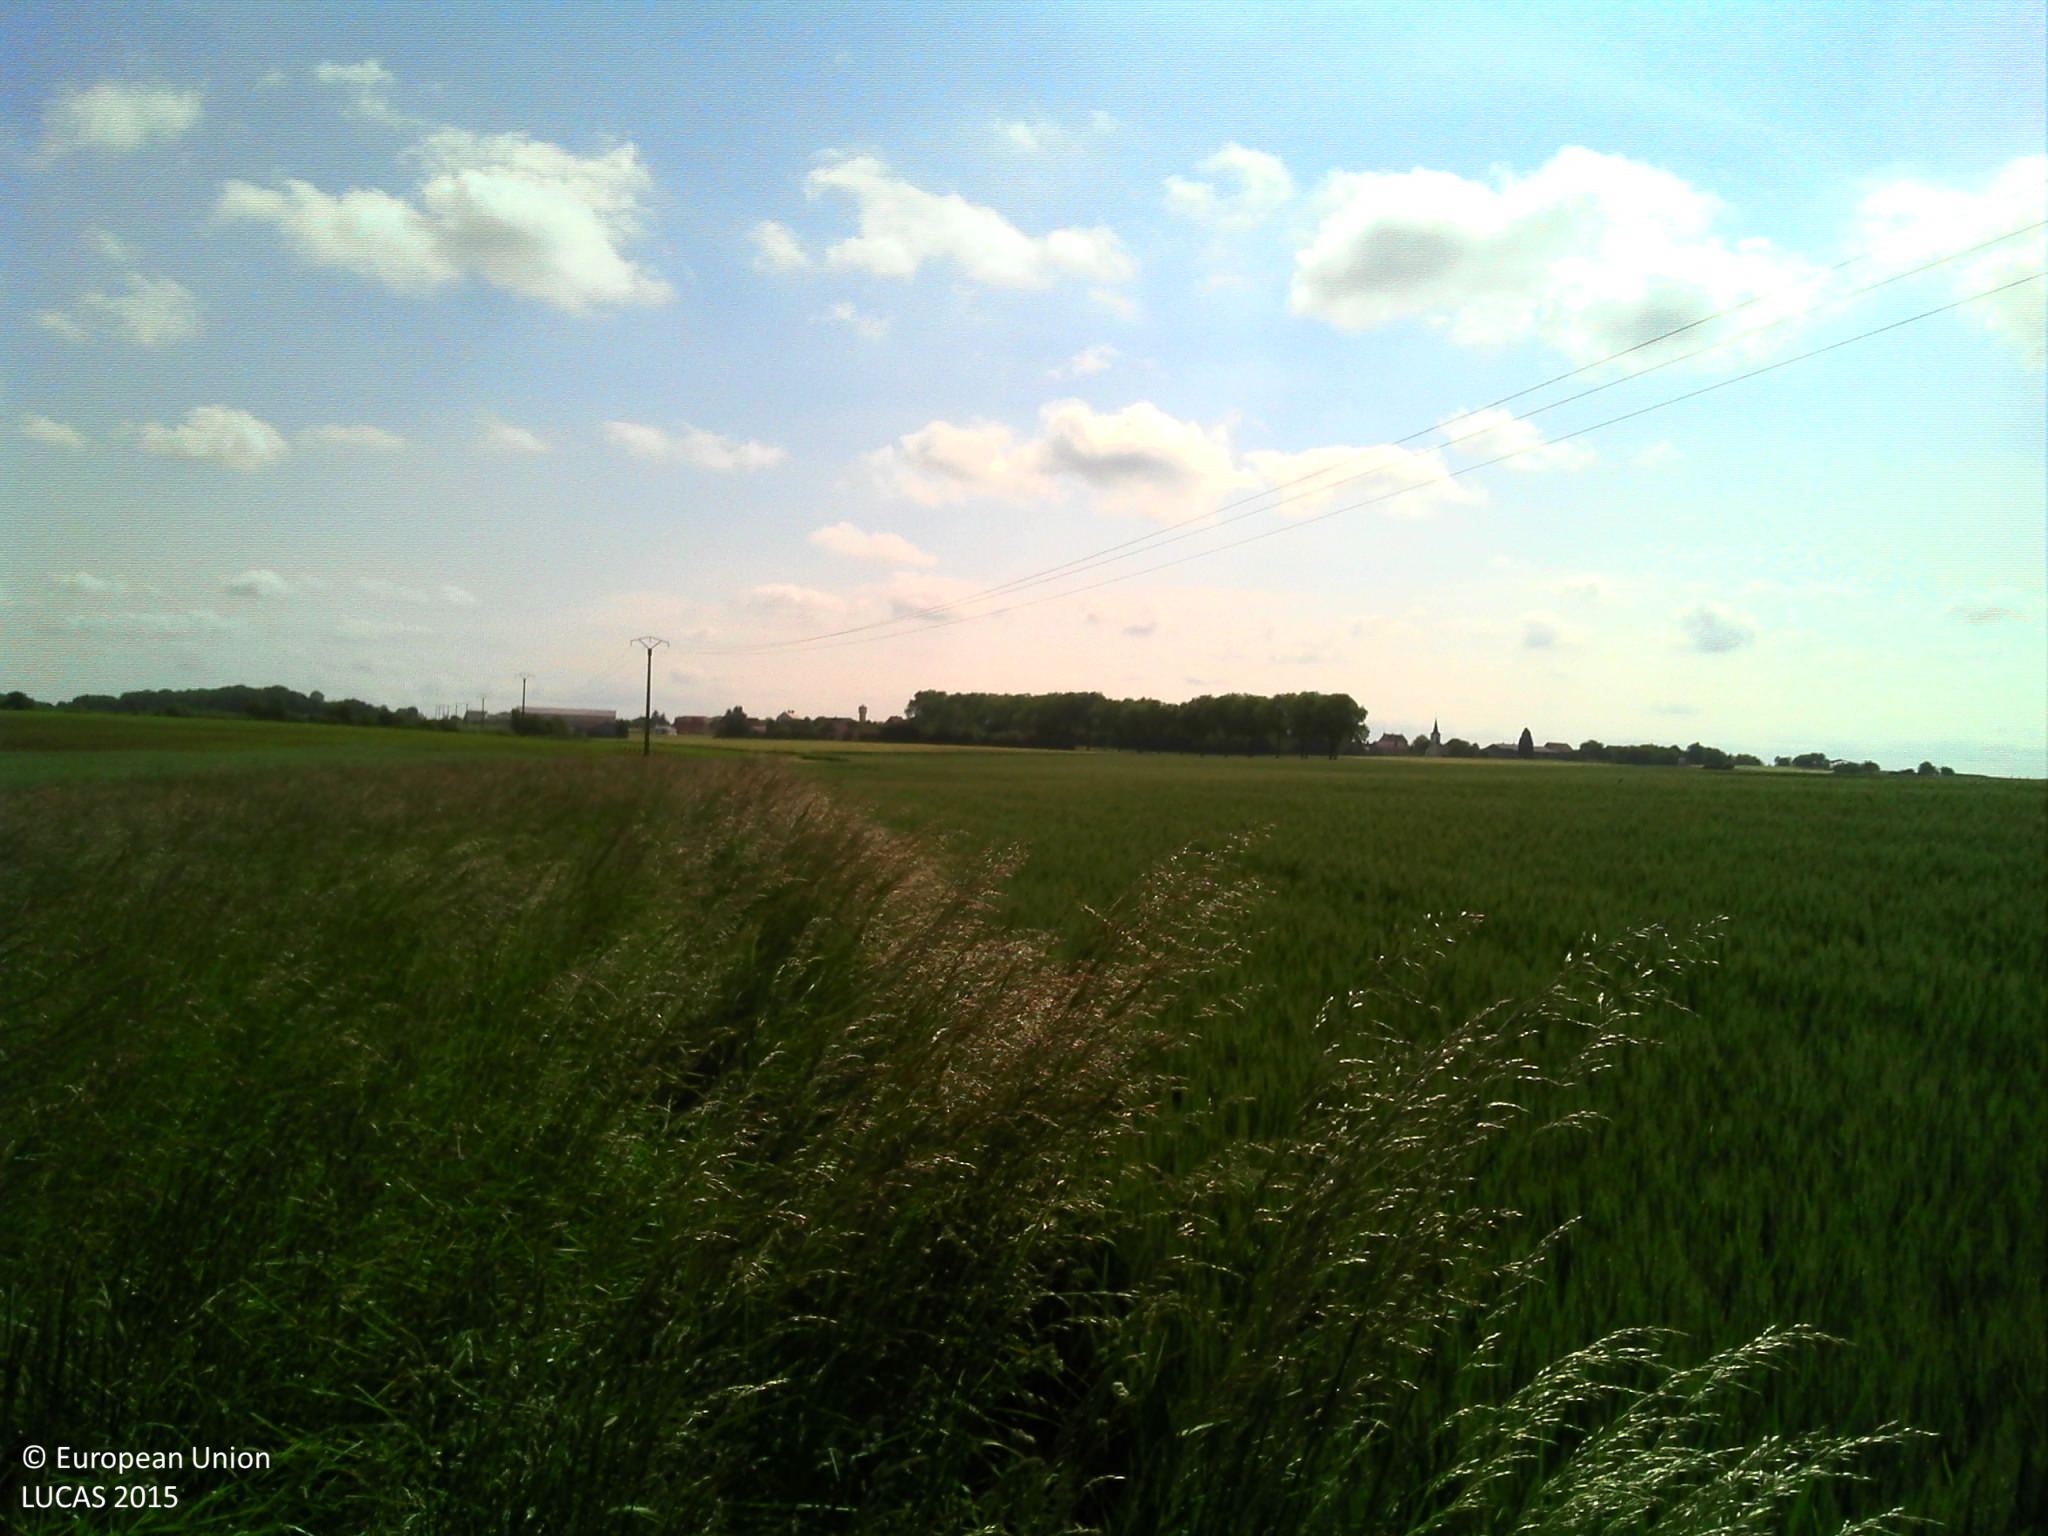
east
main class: Cropland
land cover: Common wheat
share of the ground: > 75 %
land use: Agriculture (excluding fallow land and kitchen gardens)
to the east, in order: Common wheat; Electric lines; Common wheat
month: May
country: FR
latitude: 47.4346
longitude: 5.2141
